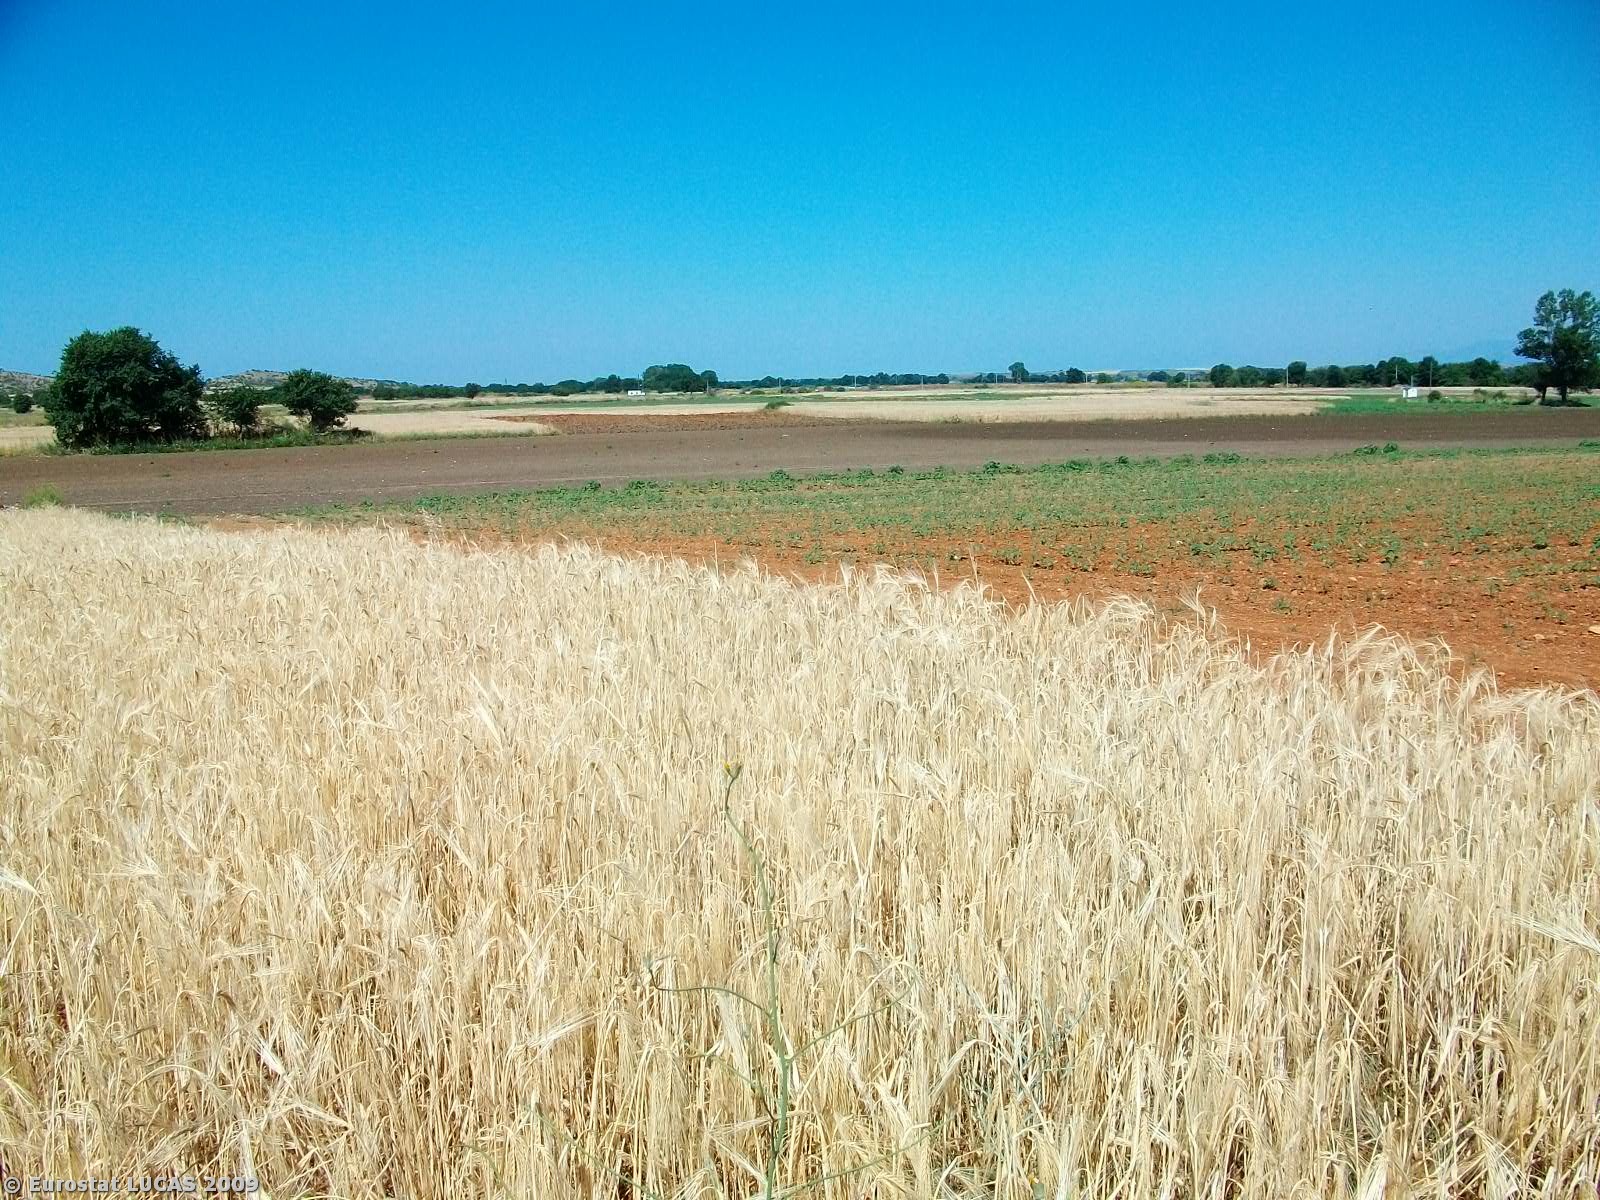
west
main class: Cropland
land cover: Barley
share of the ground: > 75 %
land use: Agriculture (excluding fallow land and kitchen gardens)
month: June
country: GR
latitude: 41.0159
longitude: 25.4736
